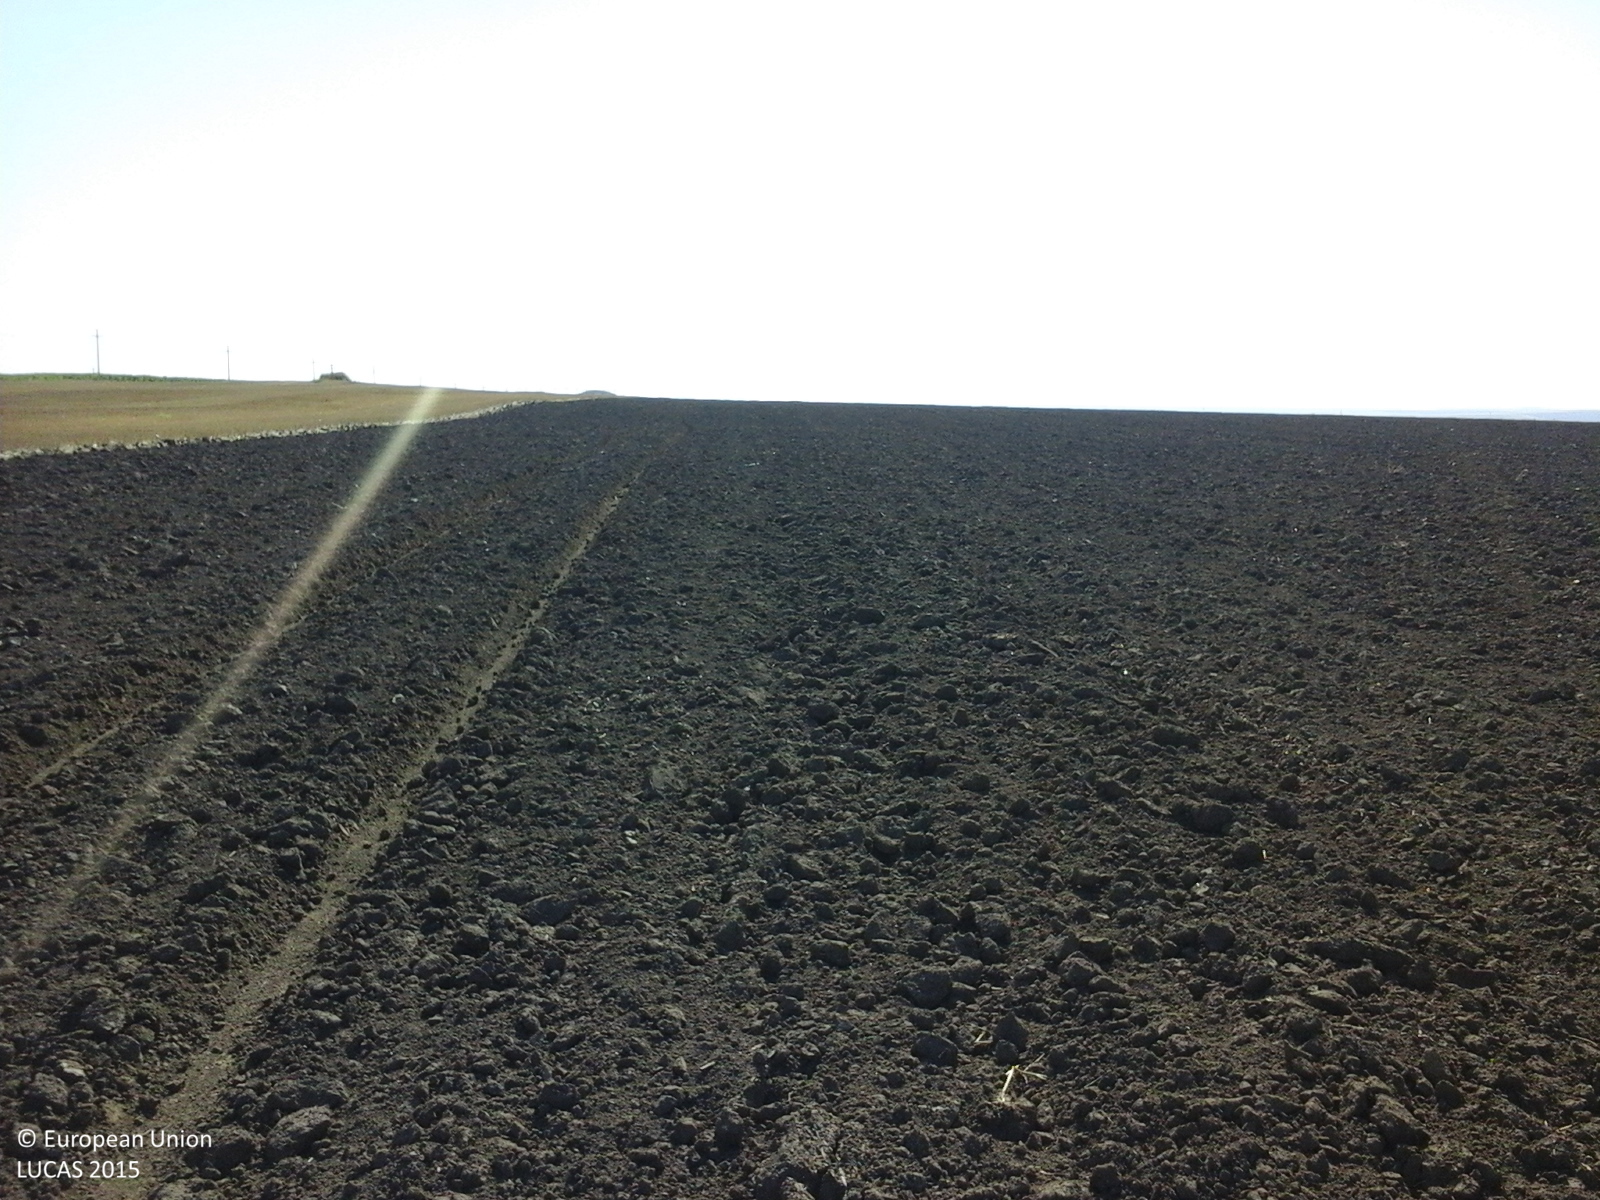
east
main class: Cropland
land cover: Common wheat
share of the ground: < 10 %
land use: Agriculture (excluding fallow land and kitchen gardens)
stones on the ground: < 10 %
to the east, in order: Common wheat
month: August
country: RO
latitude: 44.5104
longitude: 28.6319
